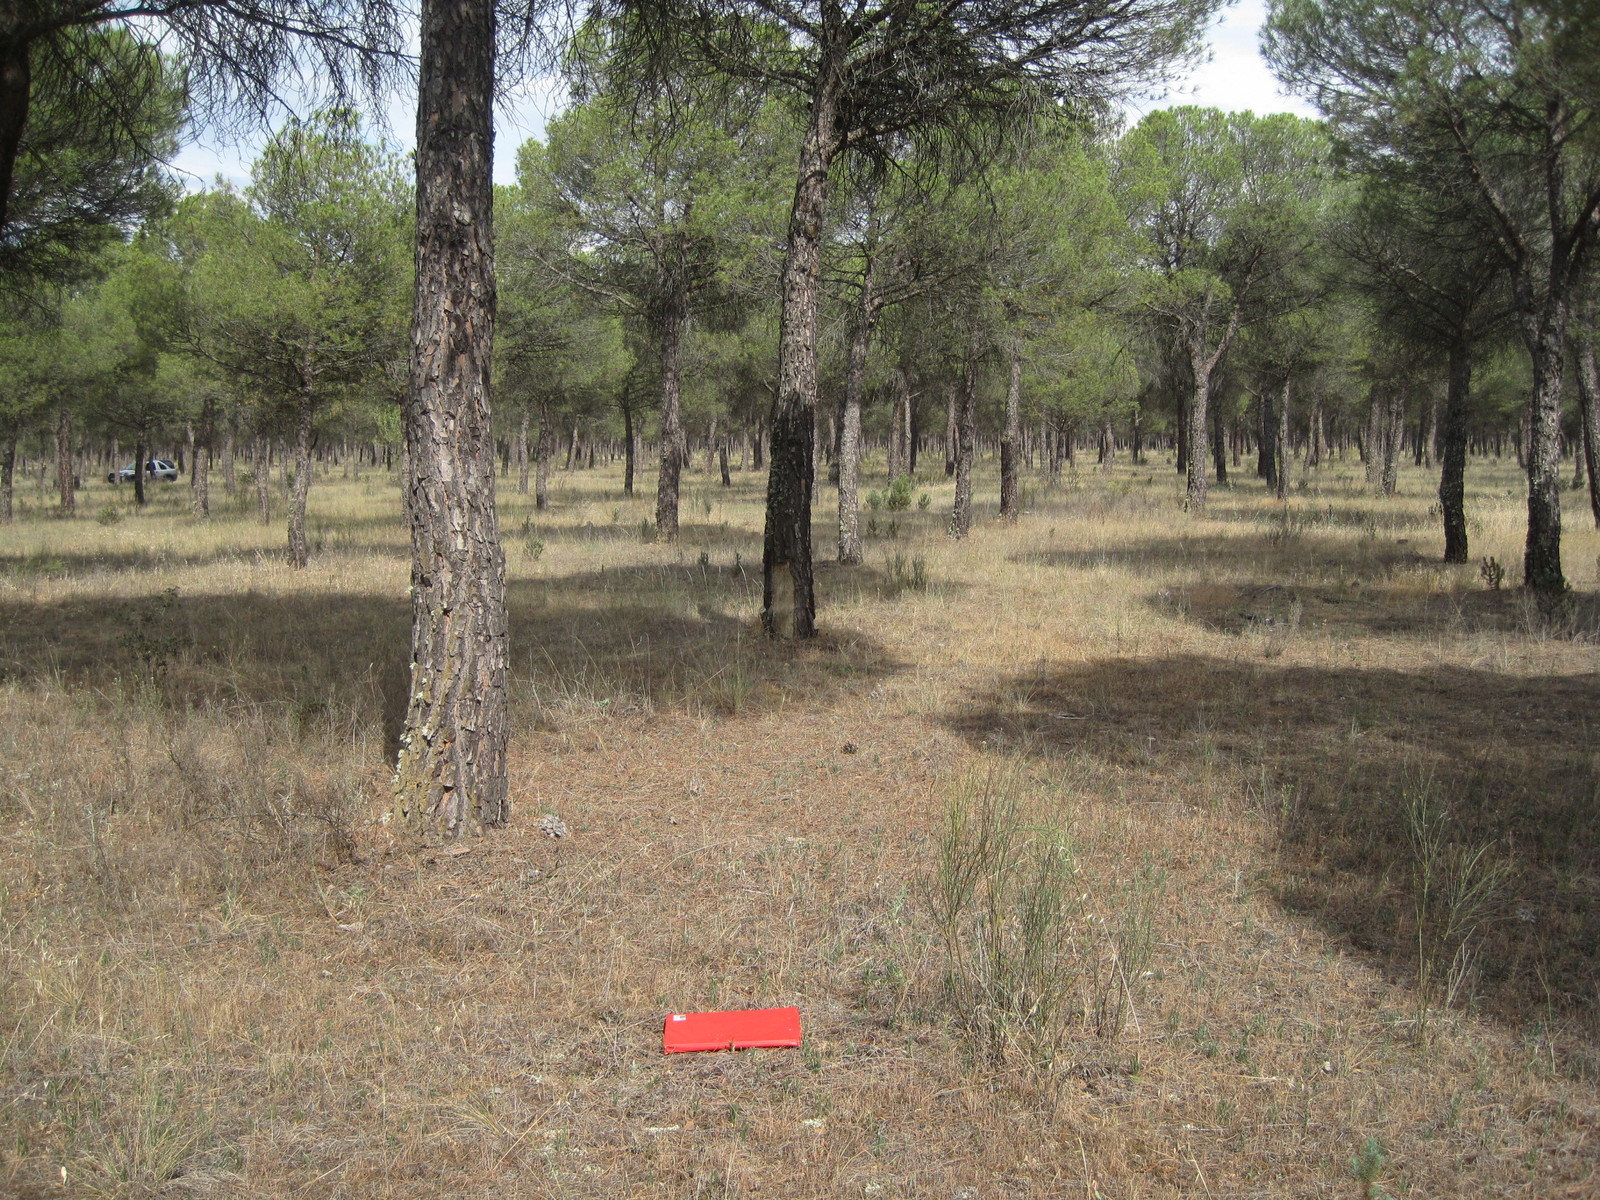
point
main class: Woodland
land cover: Pine dominated coniferous woodland
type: coniferous forest of the mediterranean region
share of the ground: 50 - 75 %
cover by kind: coniferous forest trees 70 %, herbaceous plants 30 %
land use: Forestry
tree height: > 5 m
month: June
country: ES
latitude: 41.4279
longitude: -5.0660
